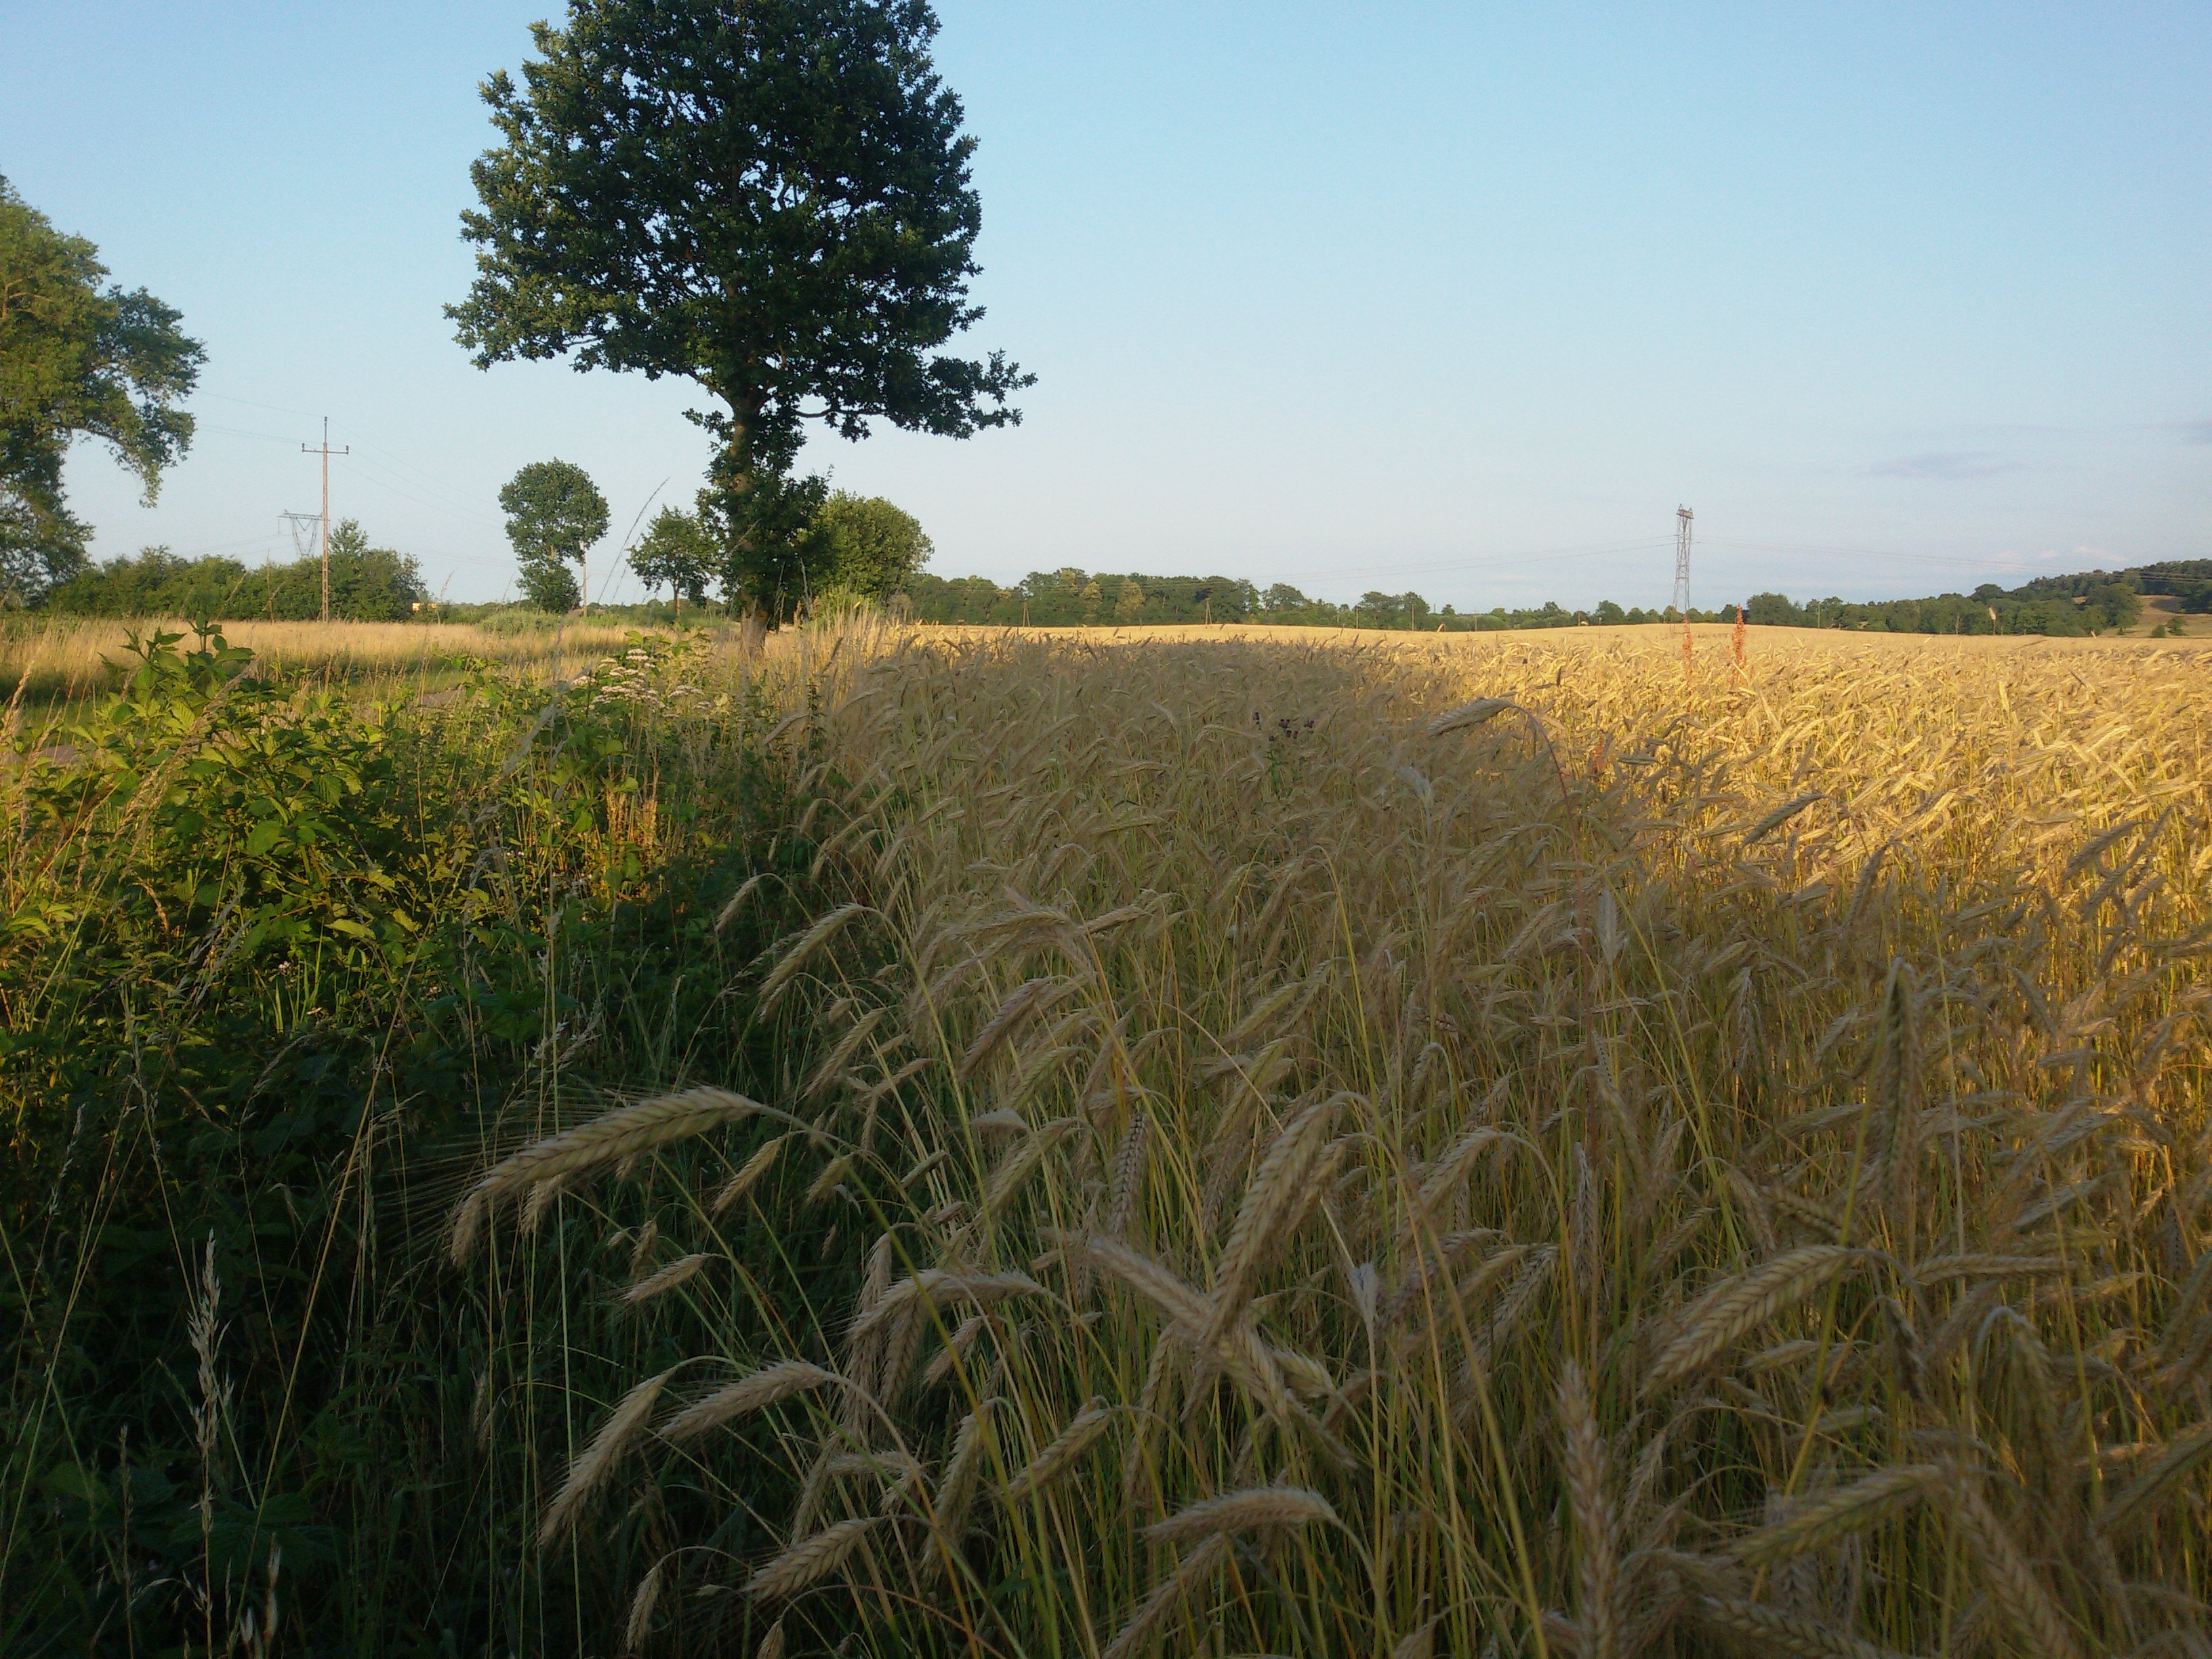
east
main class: Cropland
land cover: Rye
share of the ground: > 75 %
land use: Agriculture (excluding fallow land and kitchen gardens)
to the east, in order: Rye; Abandoned hedges
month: July
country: PL
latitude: 53.9818
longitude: 15.8443
